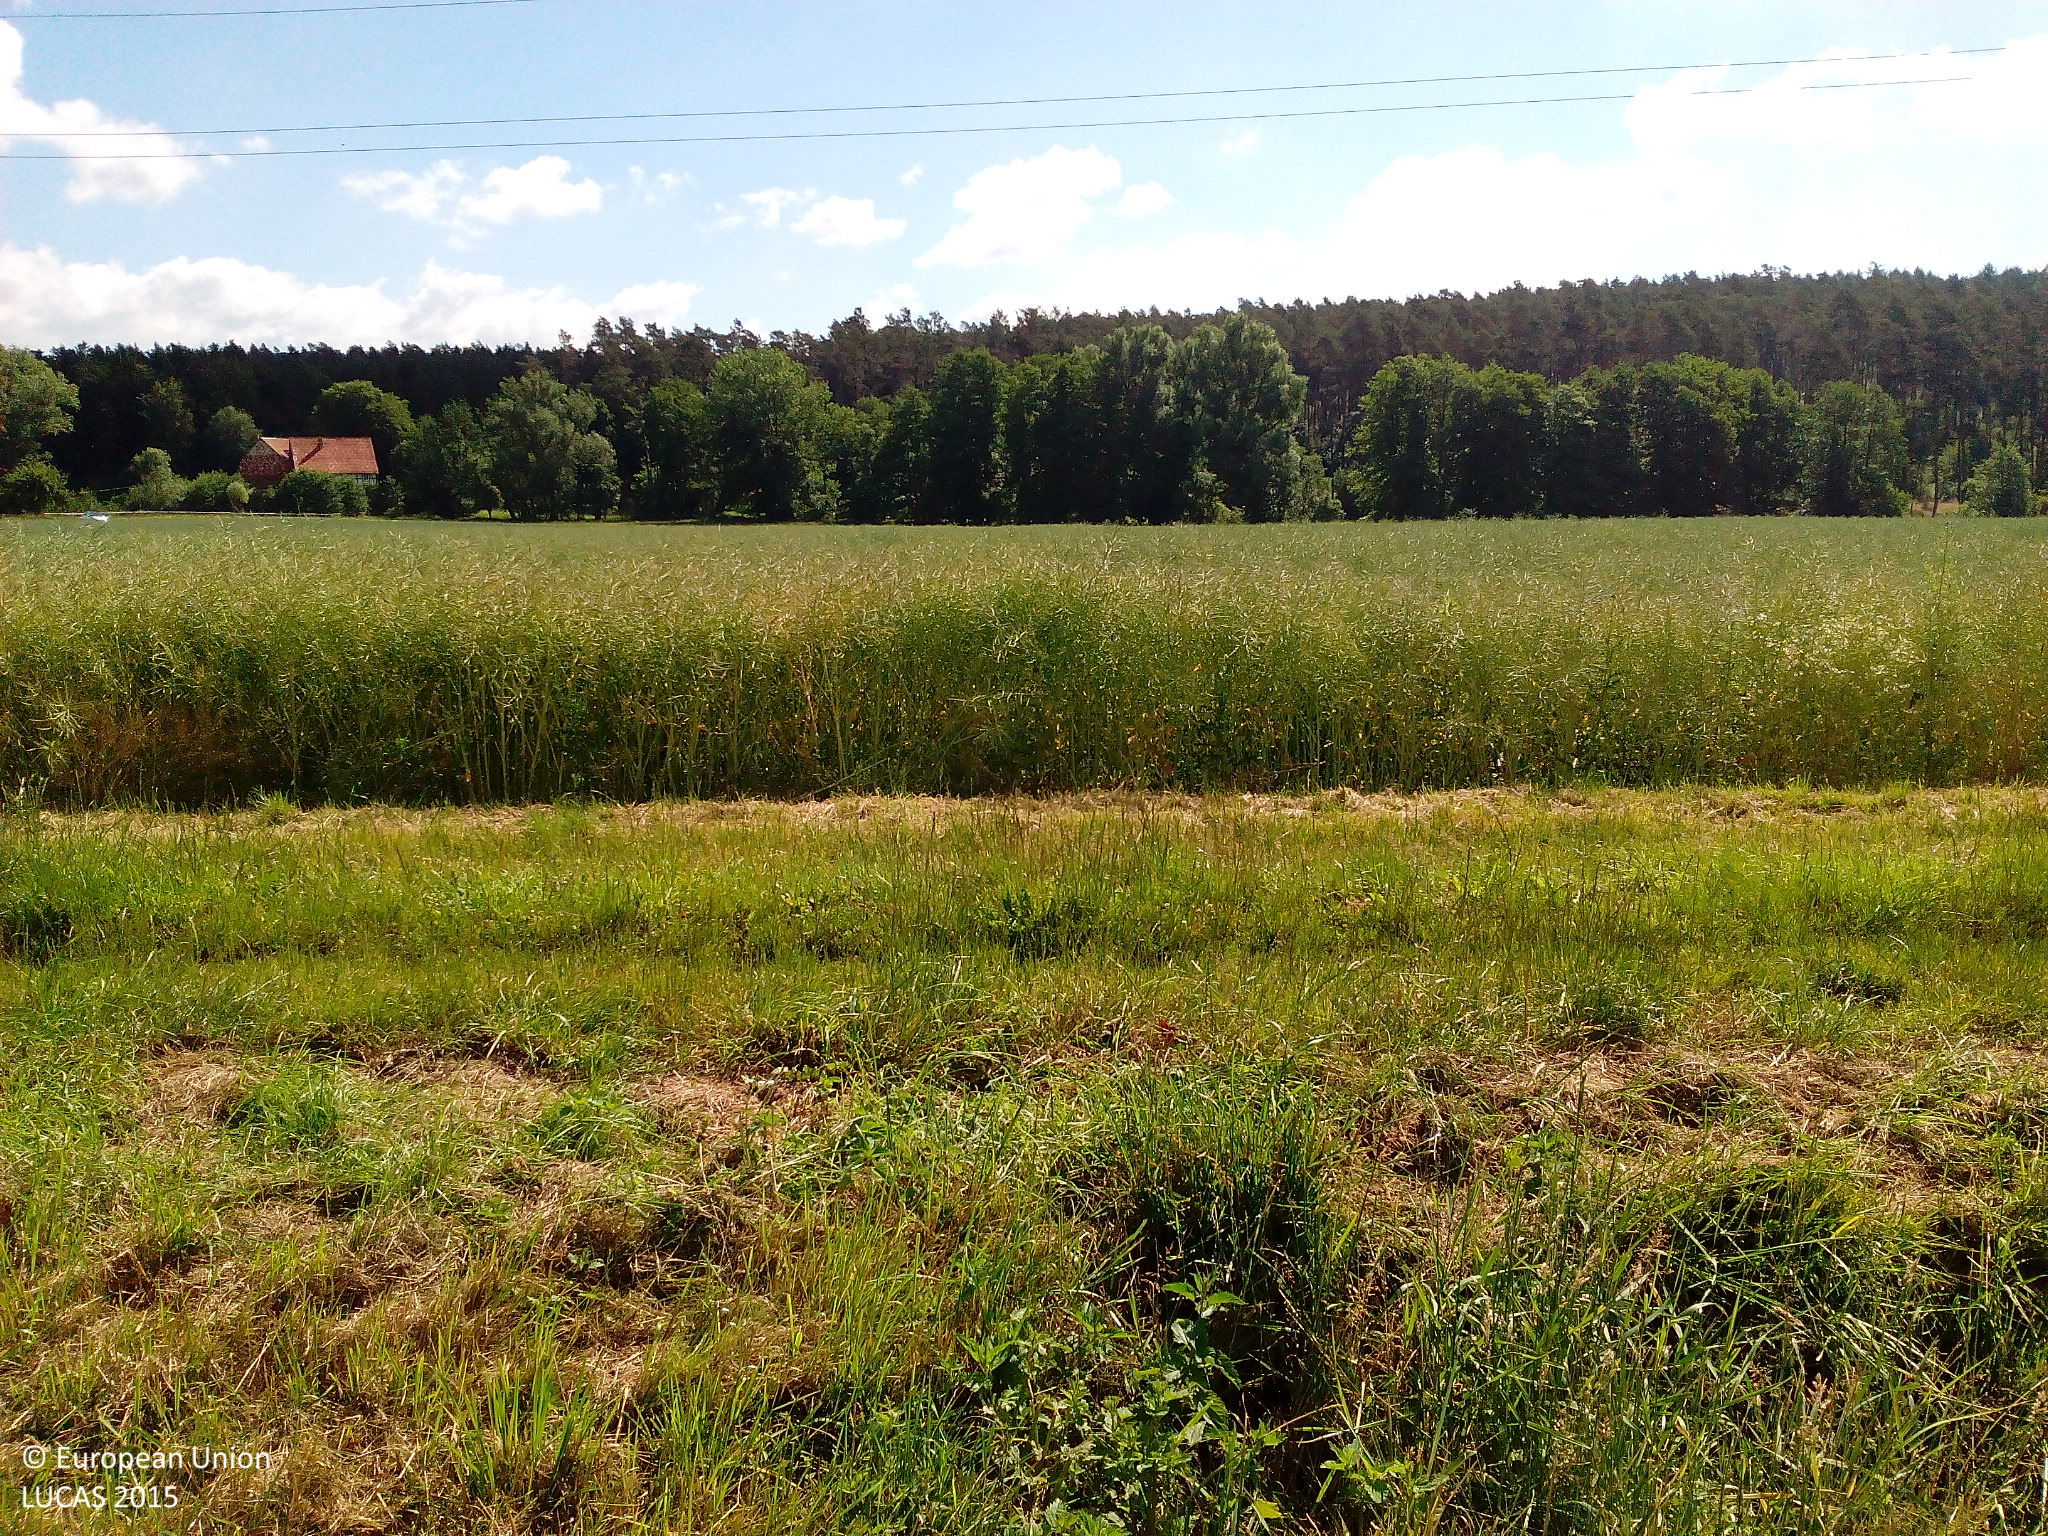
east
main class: Artificial land
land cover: Non built-up linear features
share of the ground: > 75 %
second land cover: Grassland without tree/shrub cover
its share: > 75 %
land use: Road transport
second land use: Agriculture (excluding fallow land and kitchen gardens)
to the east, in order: Grass margins; Ditches and canals; Grass margins; Tracks; Grass margins; Rape and turnip rape; Electric lines; Rape and turnip rape; Grass margins; Tracks; Grass margins; Maize; Grassland without tree/shrub cover; Broadleaved woodland; Rivers and streams; Broadleaved woodland; Grassland without tree/shrub cover
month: June
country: DE
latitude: 51.2779
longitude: 9.1544
